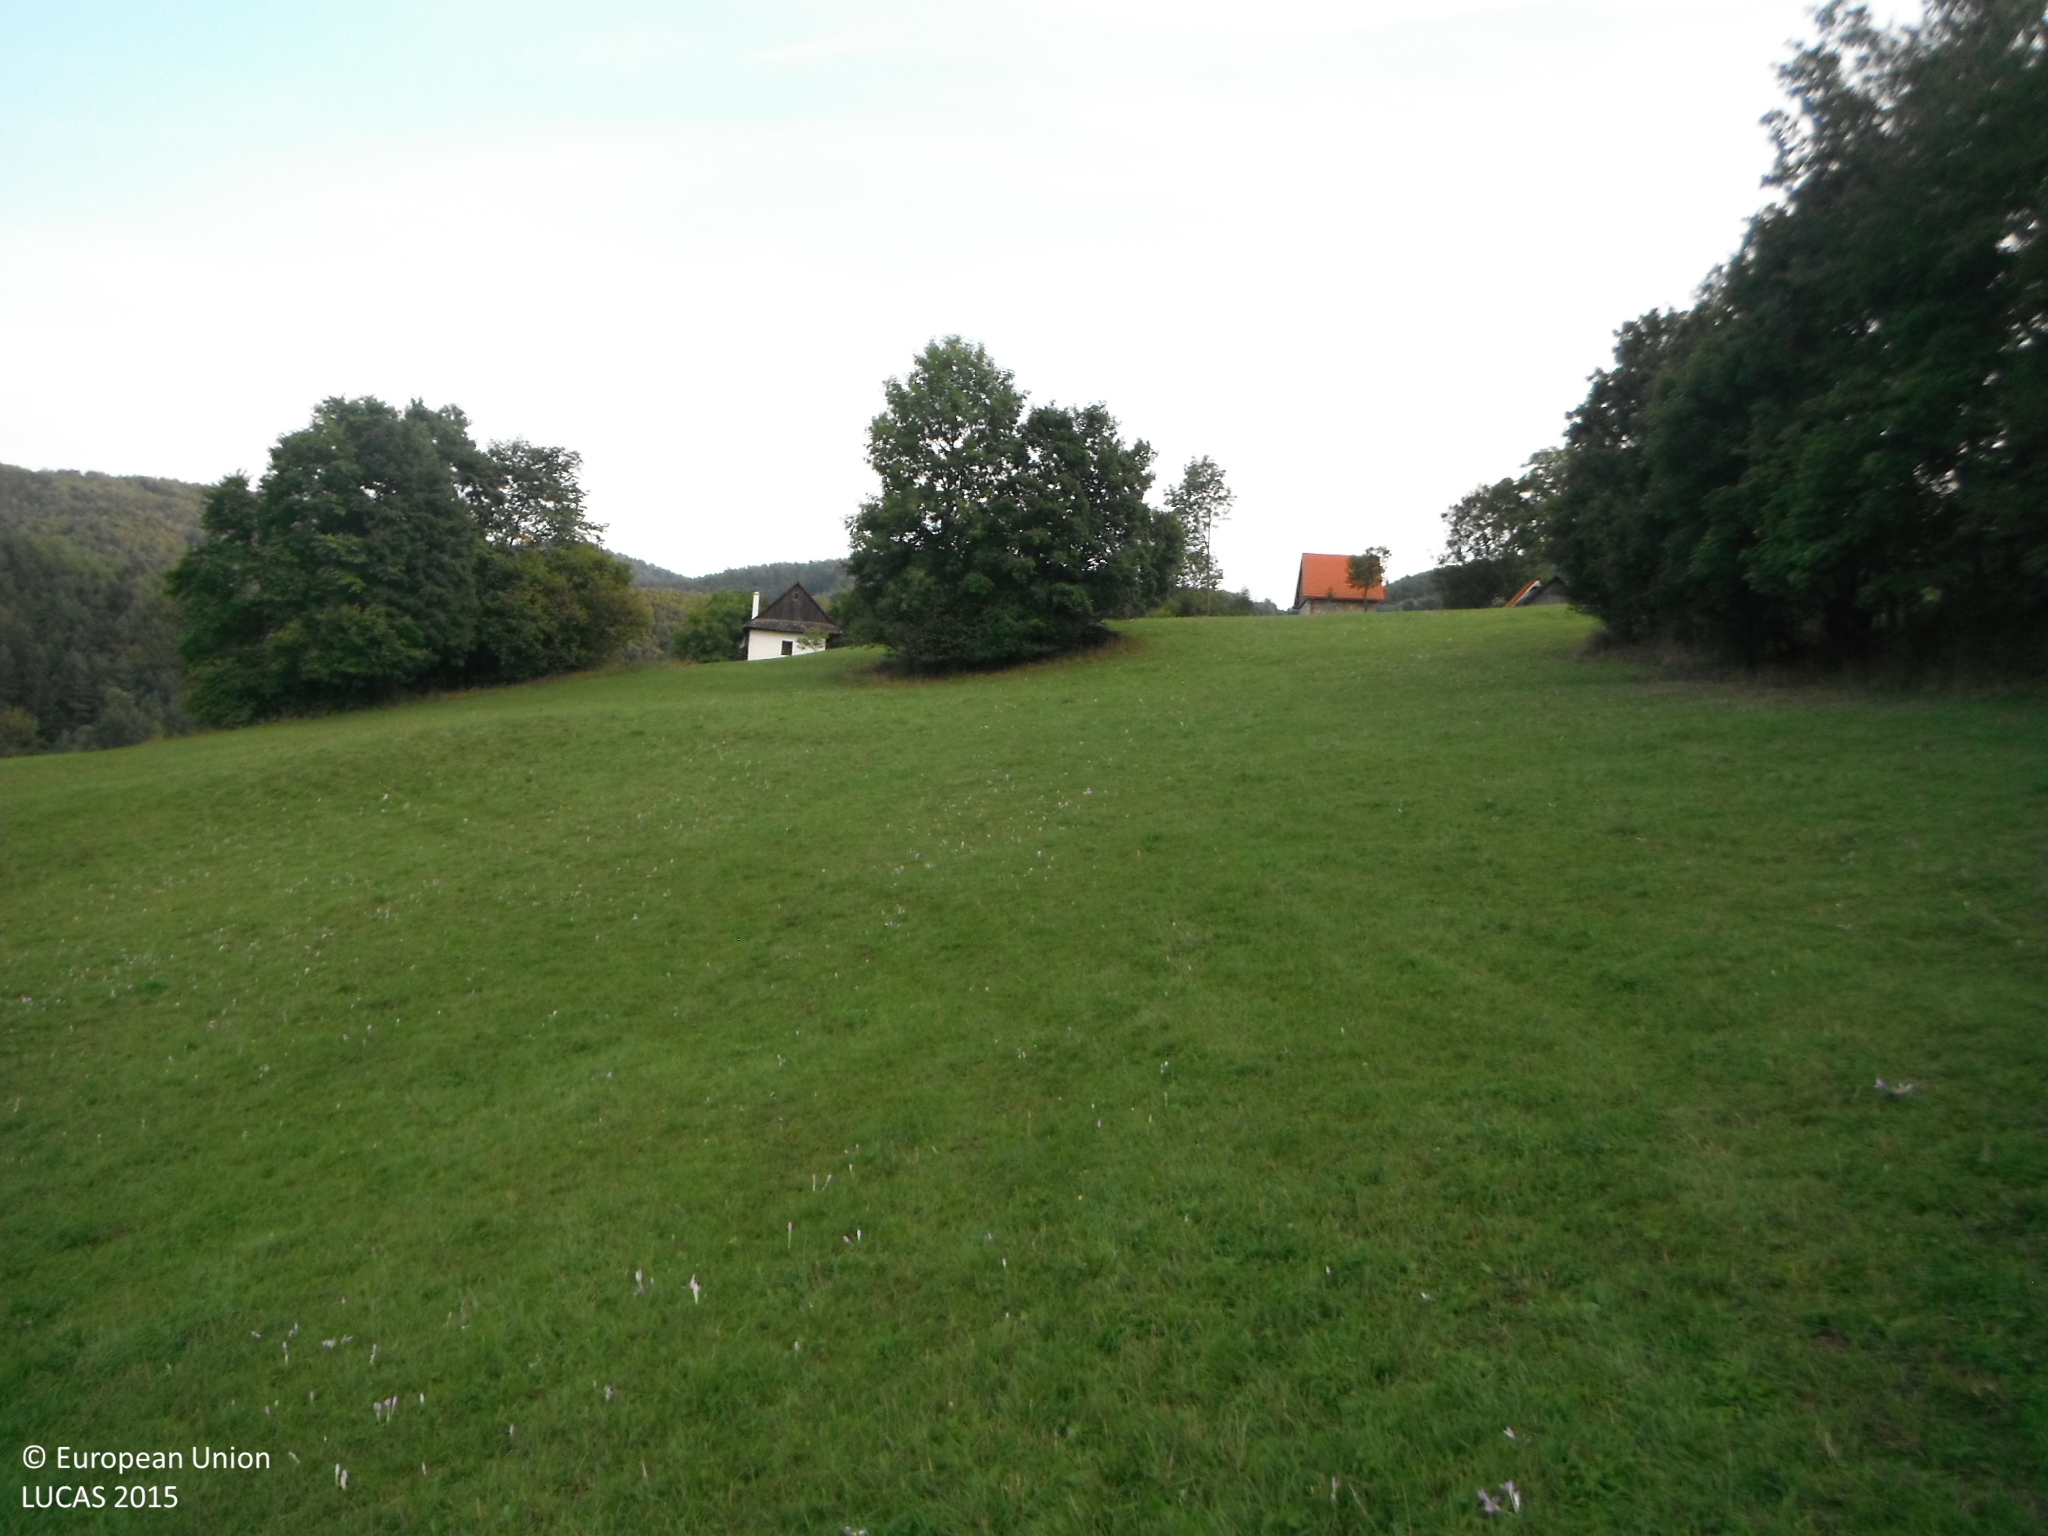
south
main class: Grassland
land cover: Grassland without tree/shrub cover
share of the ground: > 75 %
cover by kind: herbaceous plants 100 %
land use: Agriculture (excluding fallow land and kitchen gardens)
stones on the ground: < 10 %
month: September
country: SK
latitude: 48.8811
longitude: 18.3758
